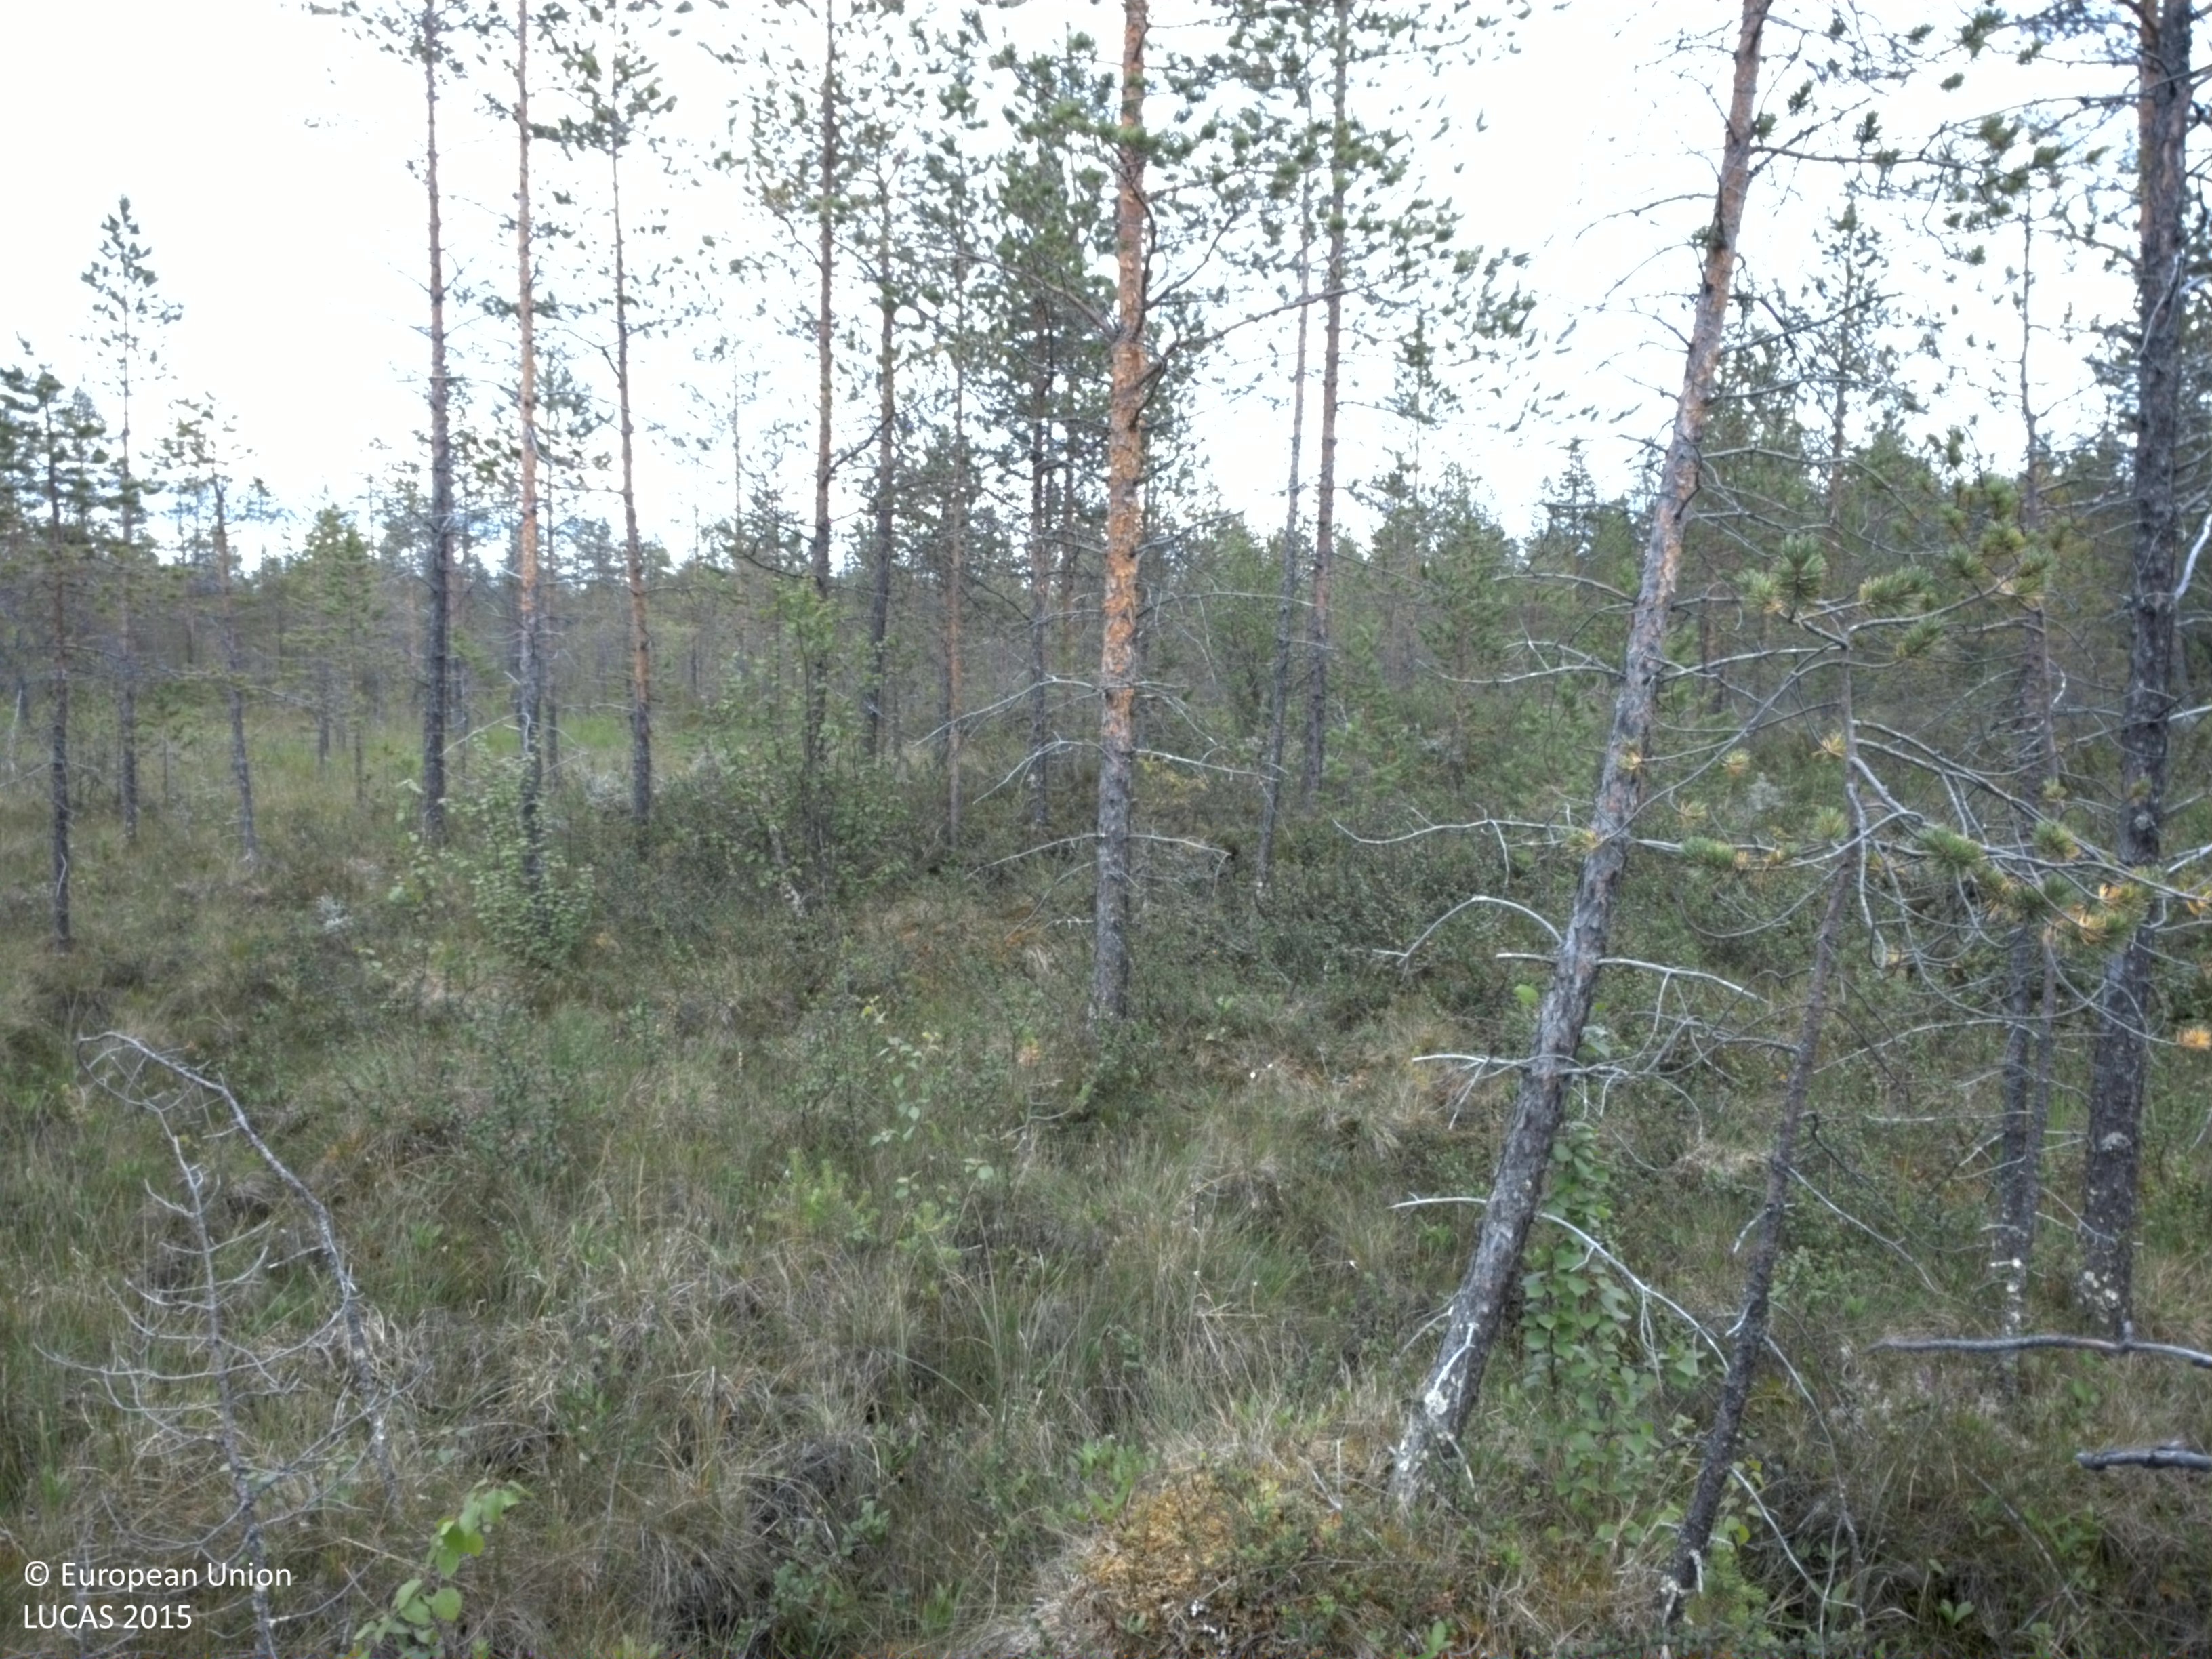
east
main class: Woodland
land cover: Pine dominated coniferous woodland
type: mire and swamp forests
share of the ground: 10 - 25 %
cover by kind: herbaceous plants 50 %, shrubs 30 %, coniferous forest trees 15 %, lichens and mosses 5 %
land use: Semi-natural and natural areas not in use
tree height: > 5 m
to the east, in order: Pine dominated coniferous woodland; Peatbogs; Pine dominated coniferous woodland; Peatbogs; Pine dominated coniferous woodland; Broadleaved woodland; Rivers and streams; Pine dominated mixed woodland; Rivers and streams; Pine dominated mixed woodland; Rivers and streams; Pine dominated mixed woodland; Pine dominated coniferous woodland
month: August
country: SE
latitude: 66.5678
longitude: 19.9361
